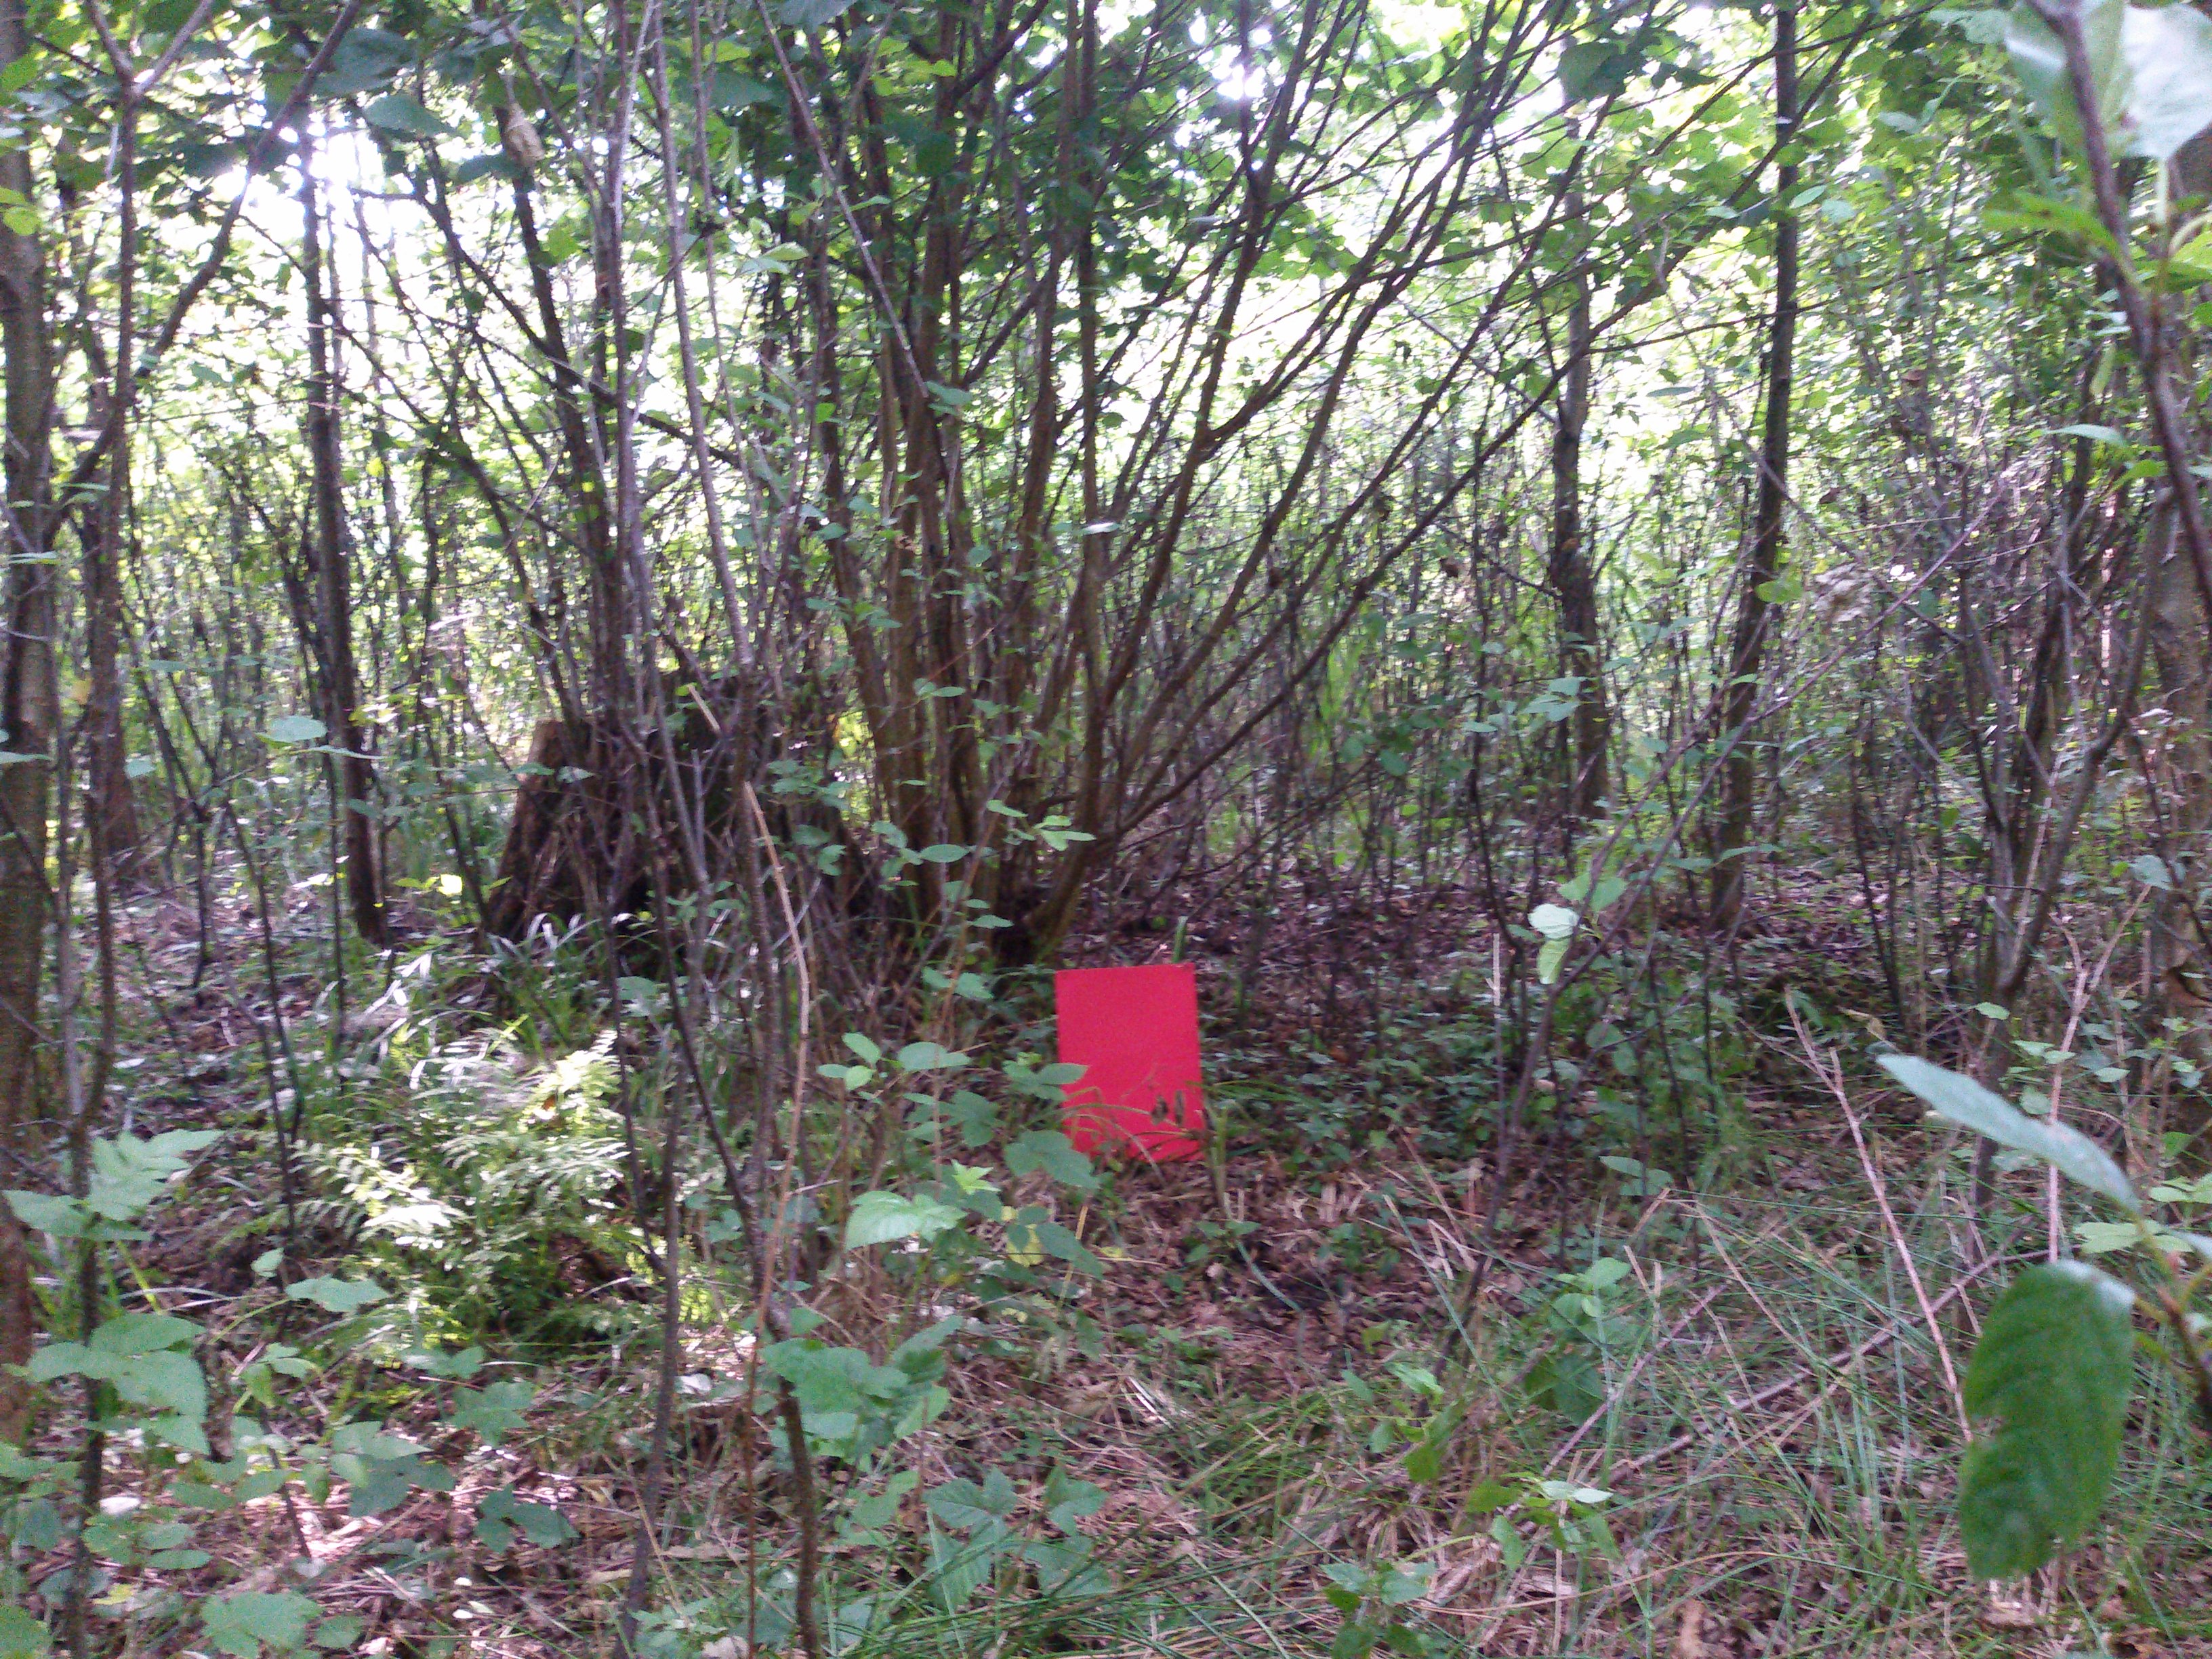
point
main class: Woodland
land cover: Broadleaved woodland
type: mesophytic deciduous forest
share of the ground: > 75 %
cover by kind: broadleaved forest trees 95 %, shrubs 5 %
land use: Semi-natural and natural areas not in use
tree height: < 5 m
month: August
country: PL
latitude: 53.3032
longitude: 16.0828
